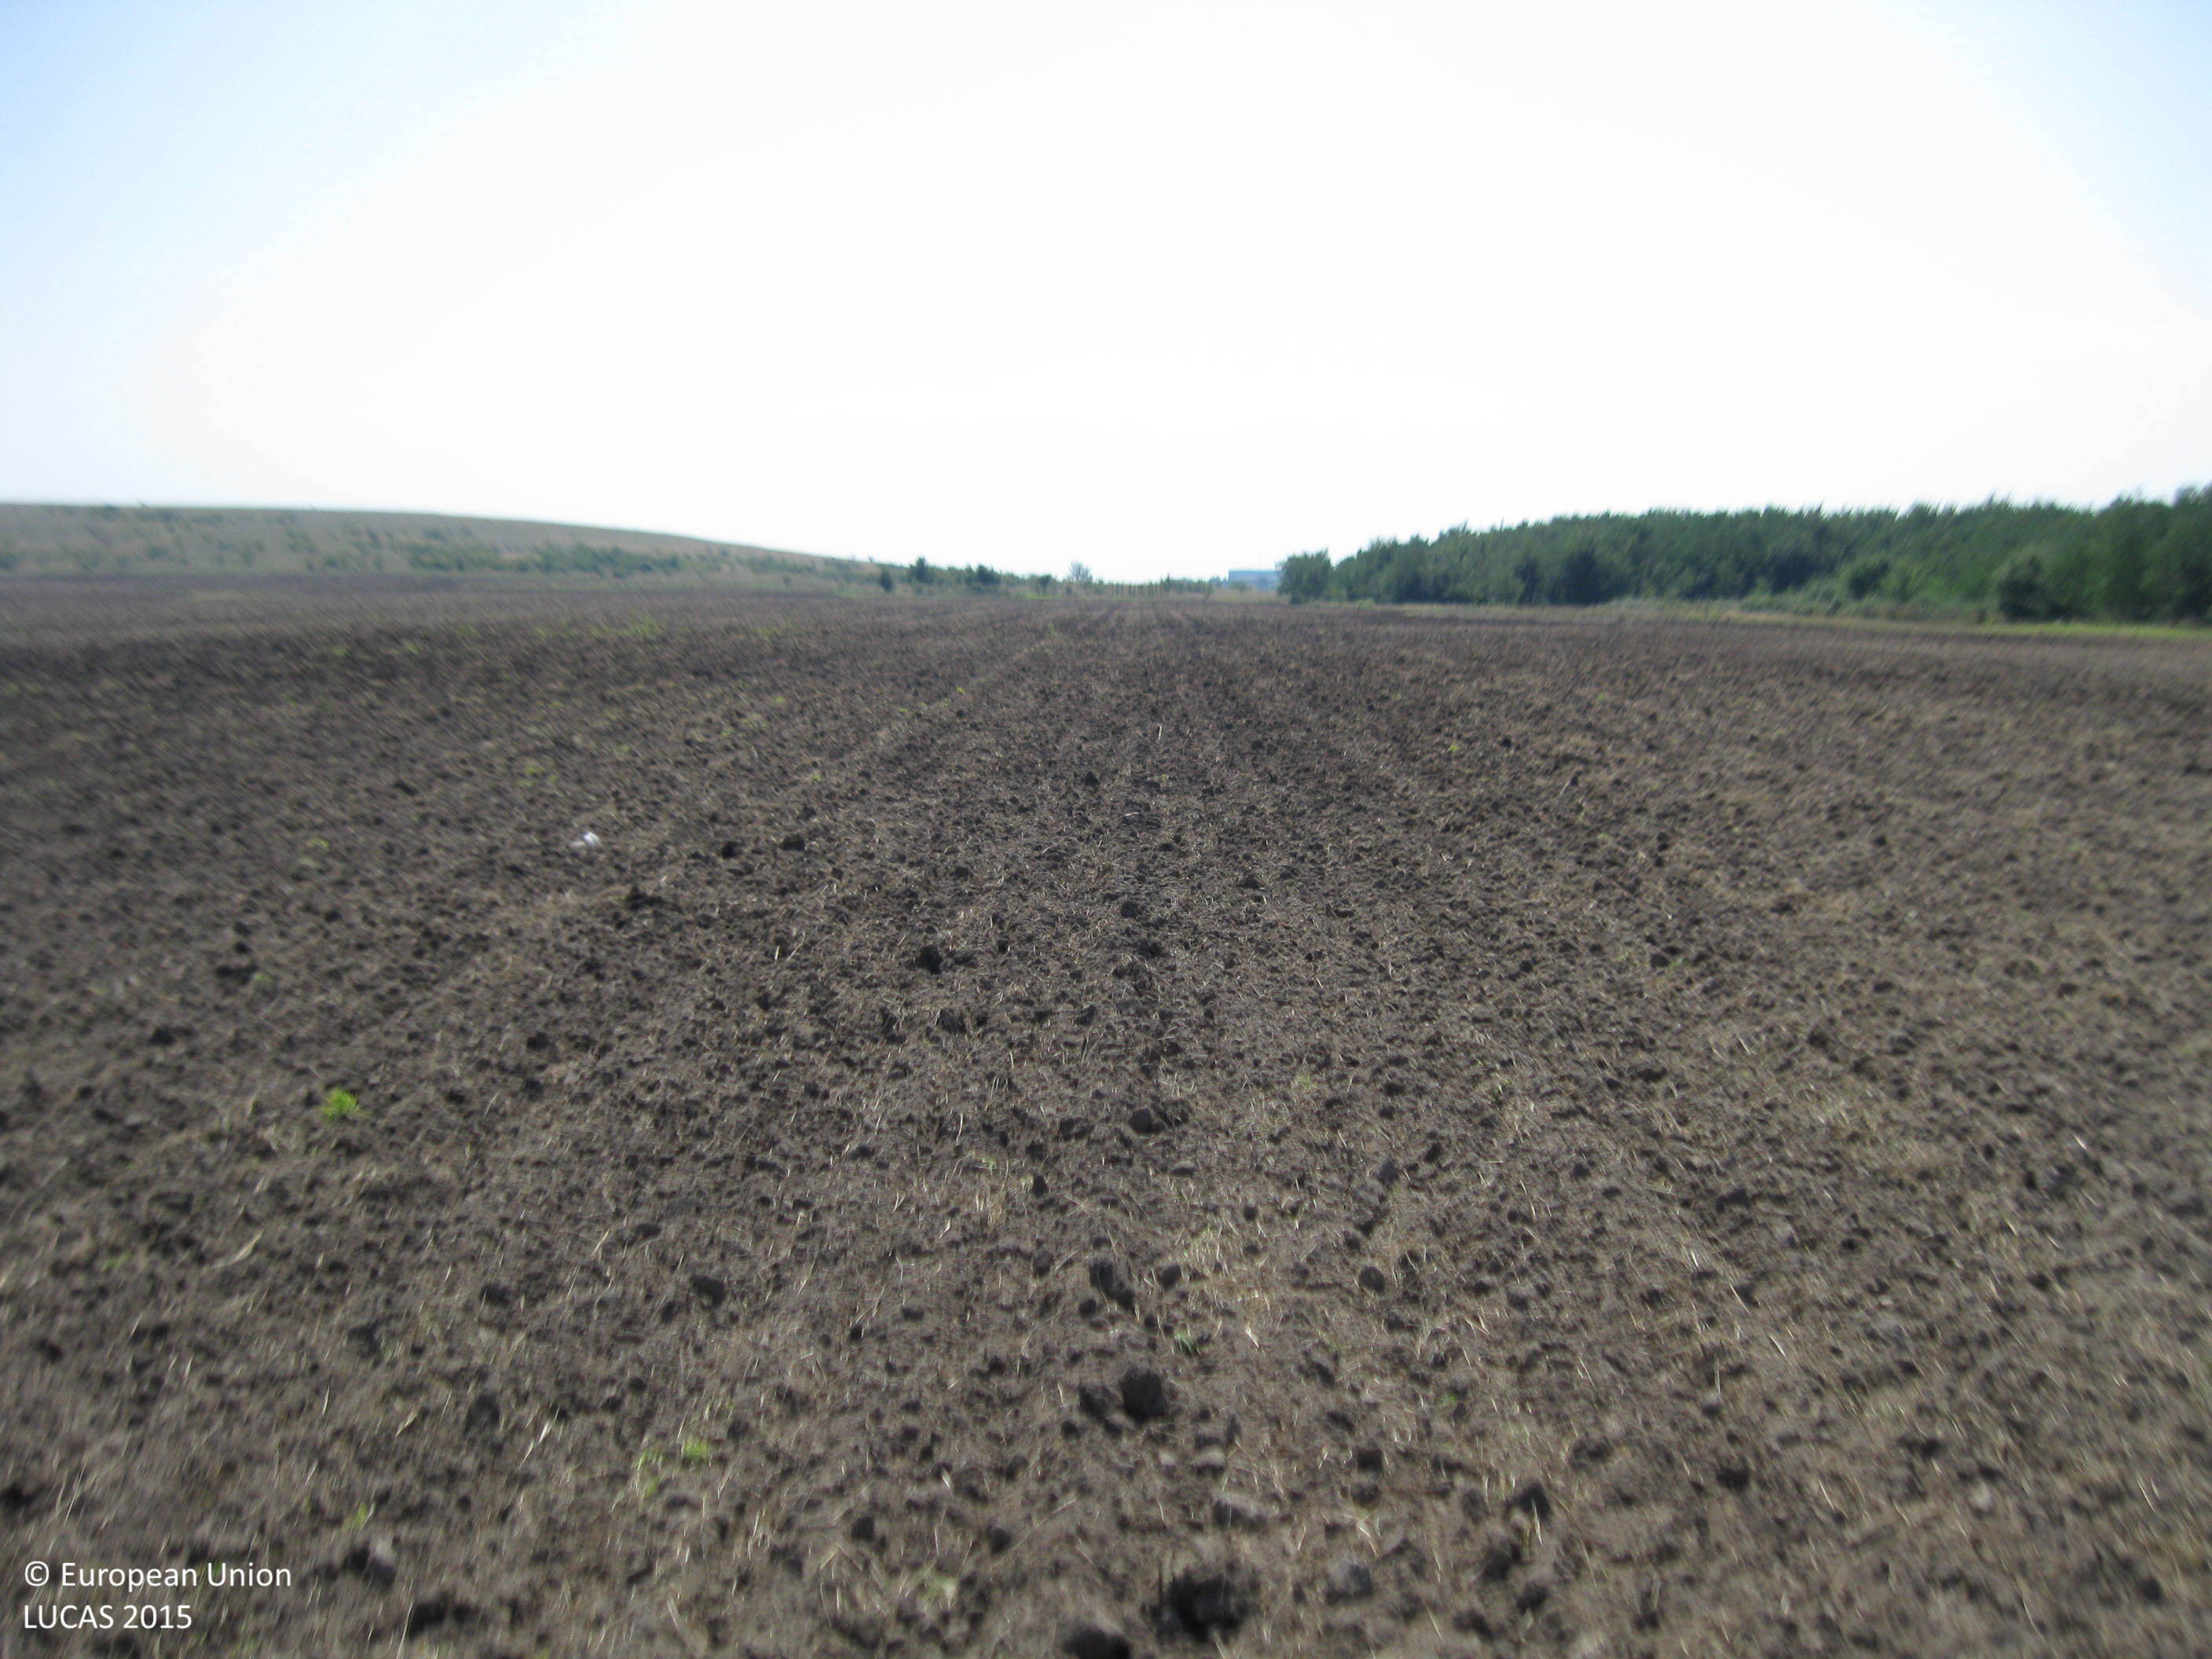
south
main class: Cropland
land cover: Common wheat
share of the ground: < 10 %
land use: Agriculture (excluding fallow land and kitchen gardens)
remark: Harvested field
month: September
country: BG
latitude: 42.2412
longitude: 25.0242
